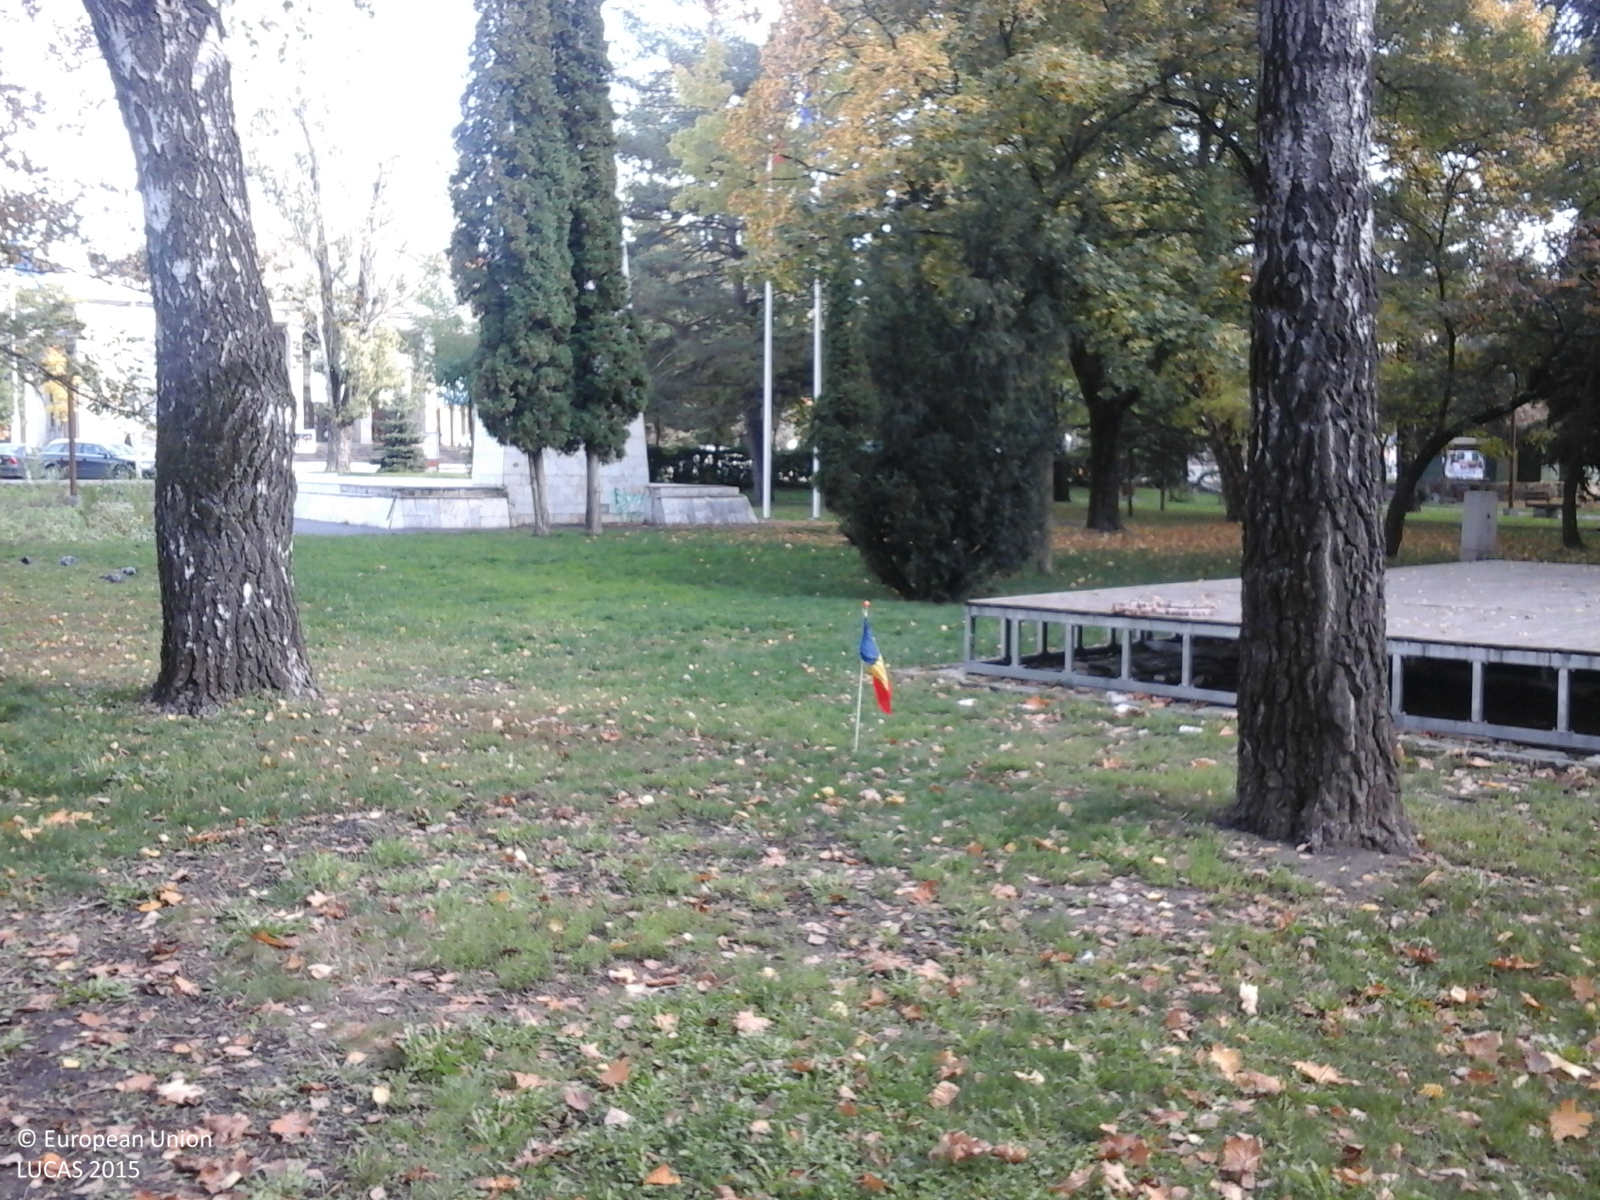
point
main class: Woodland
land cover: Broadleaved woodland
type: beech forest
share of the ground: > 75 %
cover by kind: broadleaved forest trees 80 %, herbaceous plants 20 %
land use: Amenities, museums, leisure
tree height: > 5 m
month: October
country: RO
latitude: 46.3592
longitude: 25.8021
